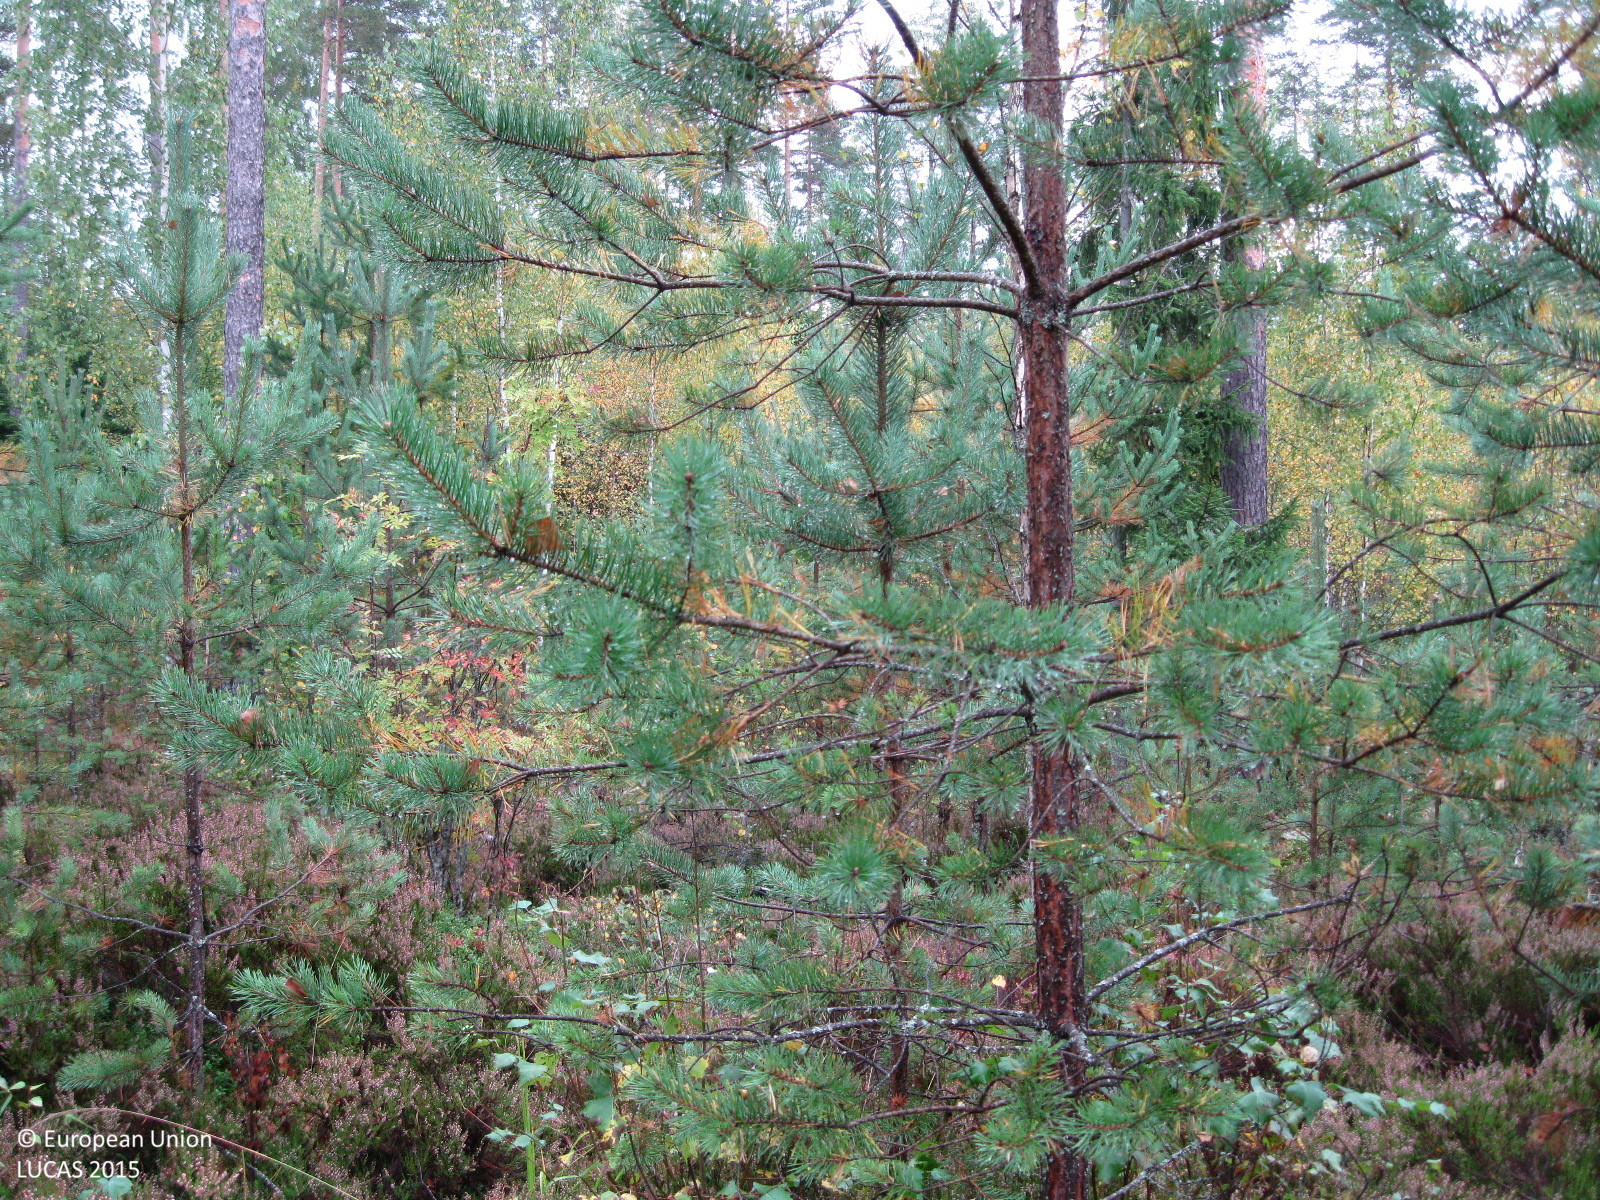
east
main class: Woodland
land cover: Pine dominated mixed woodland
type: boreal forest
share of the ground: 50 - 75 %
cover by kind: coniferous forest trees 50 %, shrubs 30 %, broadleaved forest trees 20 %
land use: Forestry
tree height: > 5 m
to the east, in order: Pine dominated mixed woodland; Spruce dominated mixed woodland
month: September
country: FI
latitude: 60.8774
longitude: 25.0166
